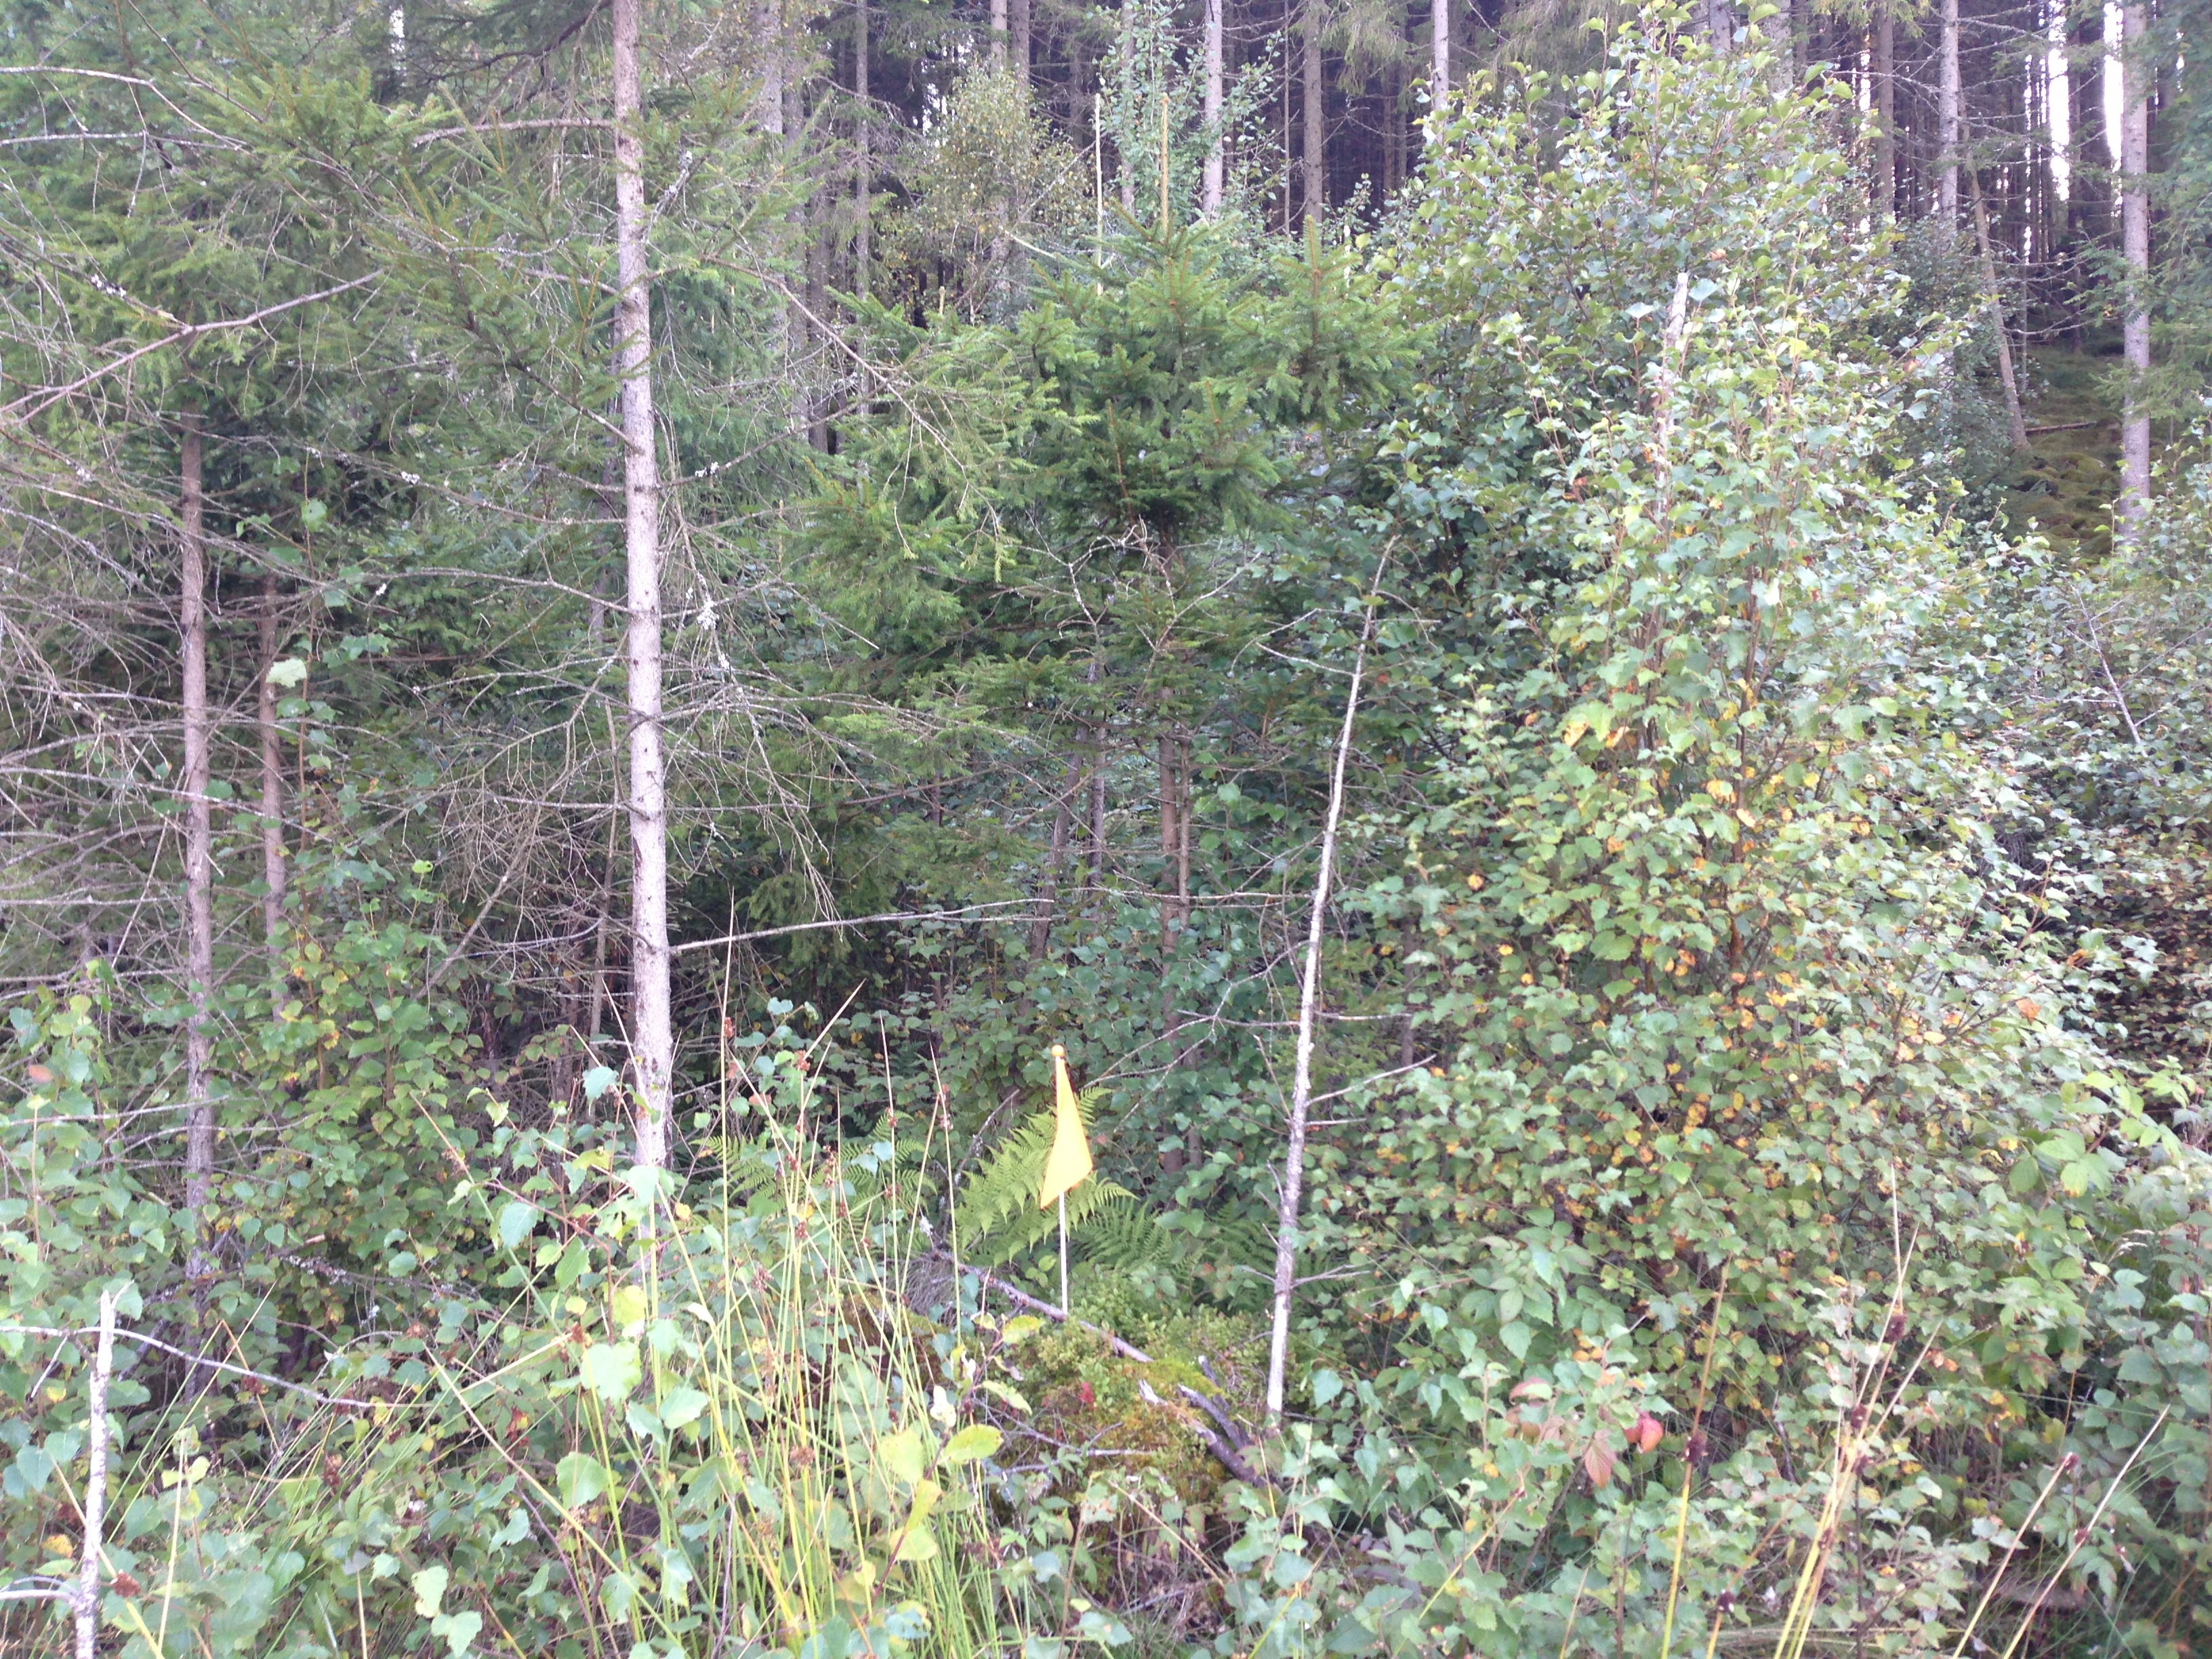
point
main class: Woodland
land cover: Spruce dominated mixed woodland
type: boreal forest
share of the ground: 50 - 75 %
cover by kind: broadleaved forest trees 40 %, coniferous forest trees 25 %, shrubs 25 %, herbaceous plants 10 %
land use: Forestry
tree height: < 5 m
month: September
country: SE
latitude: 57.2448
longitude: 13.2275
